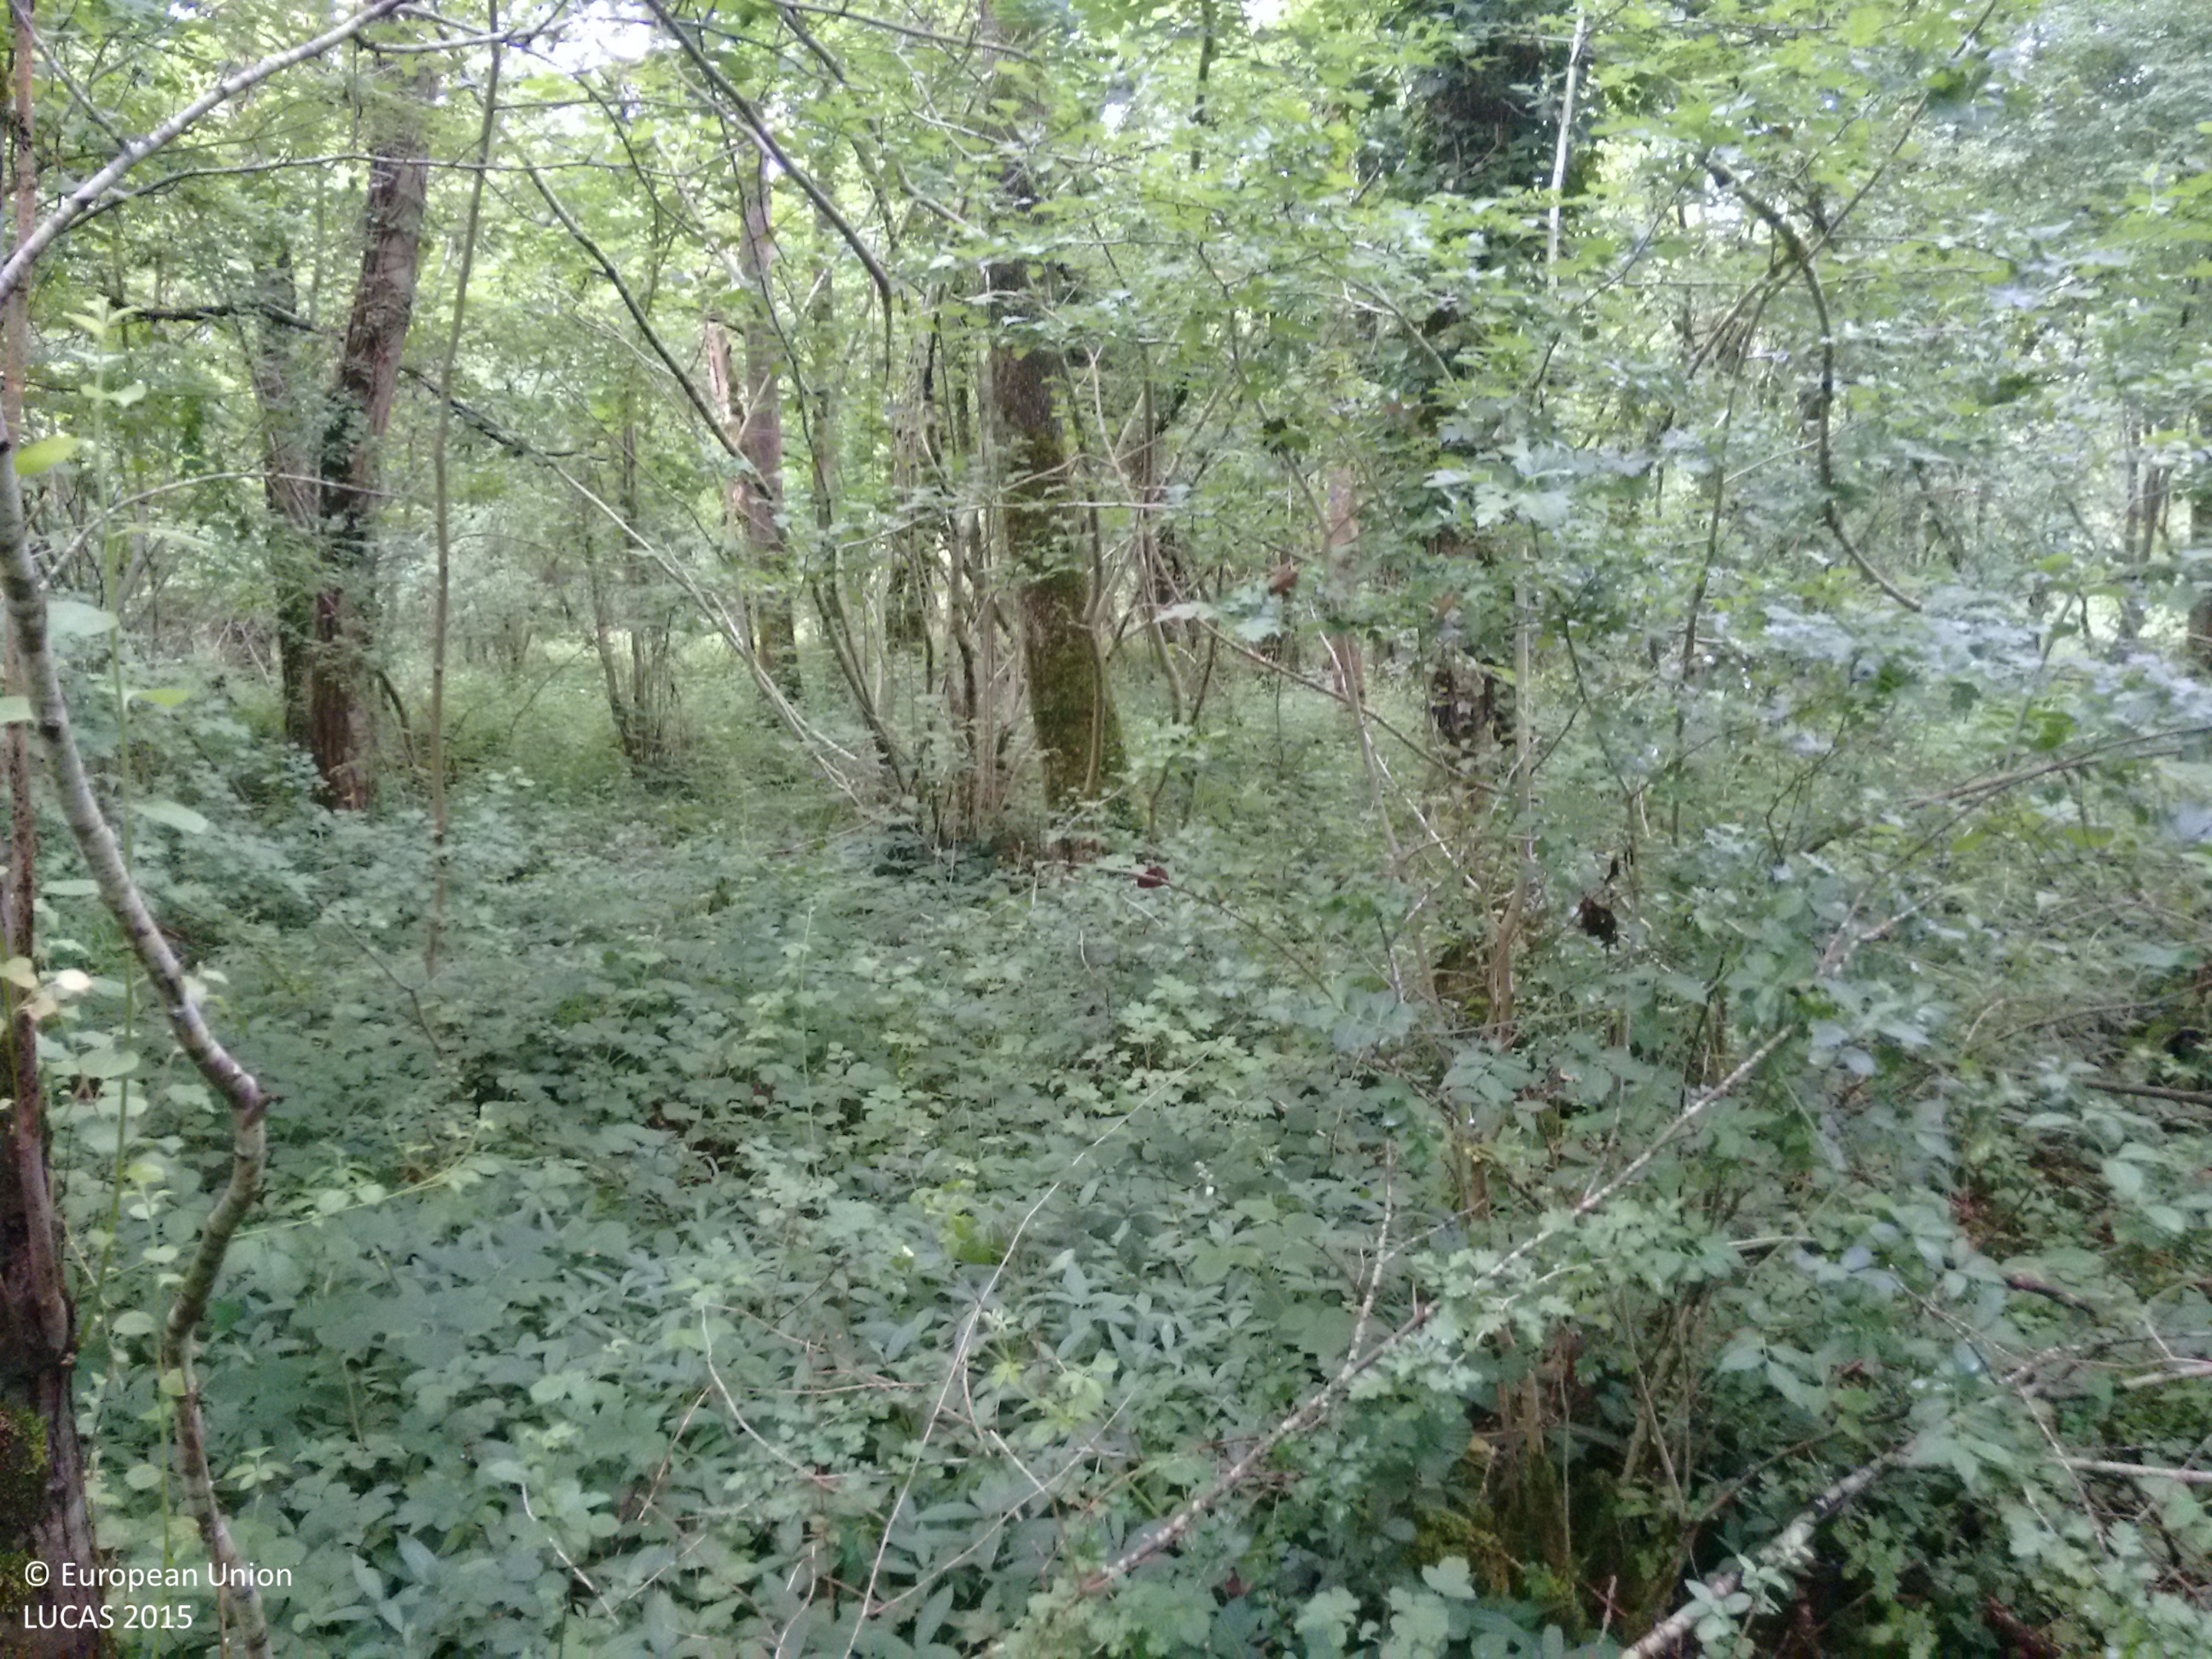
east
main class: Woodland
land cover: Broadleaved woodland
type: mesophytic deciduous forest
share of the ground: > 75 %
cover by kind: broadleaved forest trees 100 %
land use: Semi-natural and natural areas not in use
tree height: > 5 m
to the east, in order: Broadleaved woodland; Railways; Broadleaved woodland; Inland fresh running water; Broadleaved woodland; Tracks; Broadleaved woodland; Fences; Grass margins; Other fibre and oleaginous crops
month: June
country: GB
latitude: 51.2364
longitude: -2.3675
